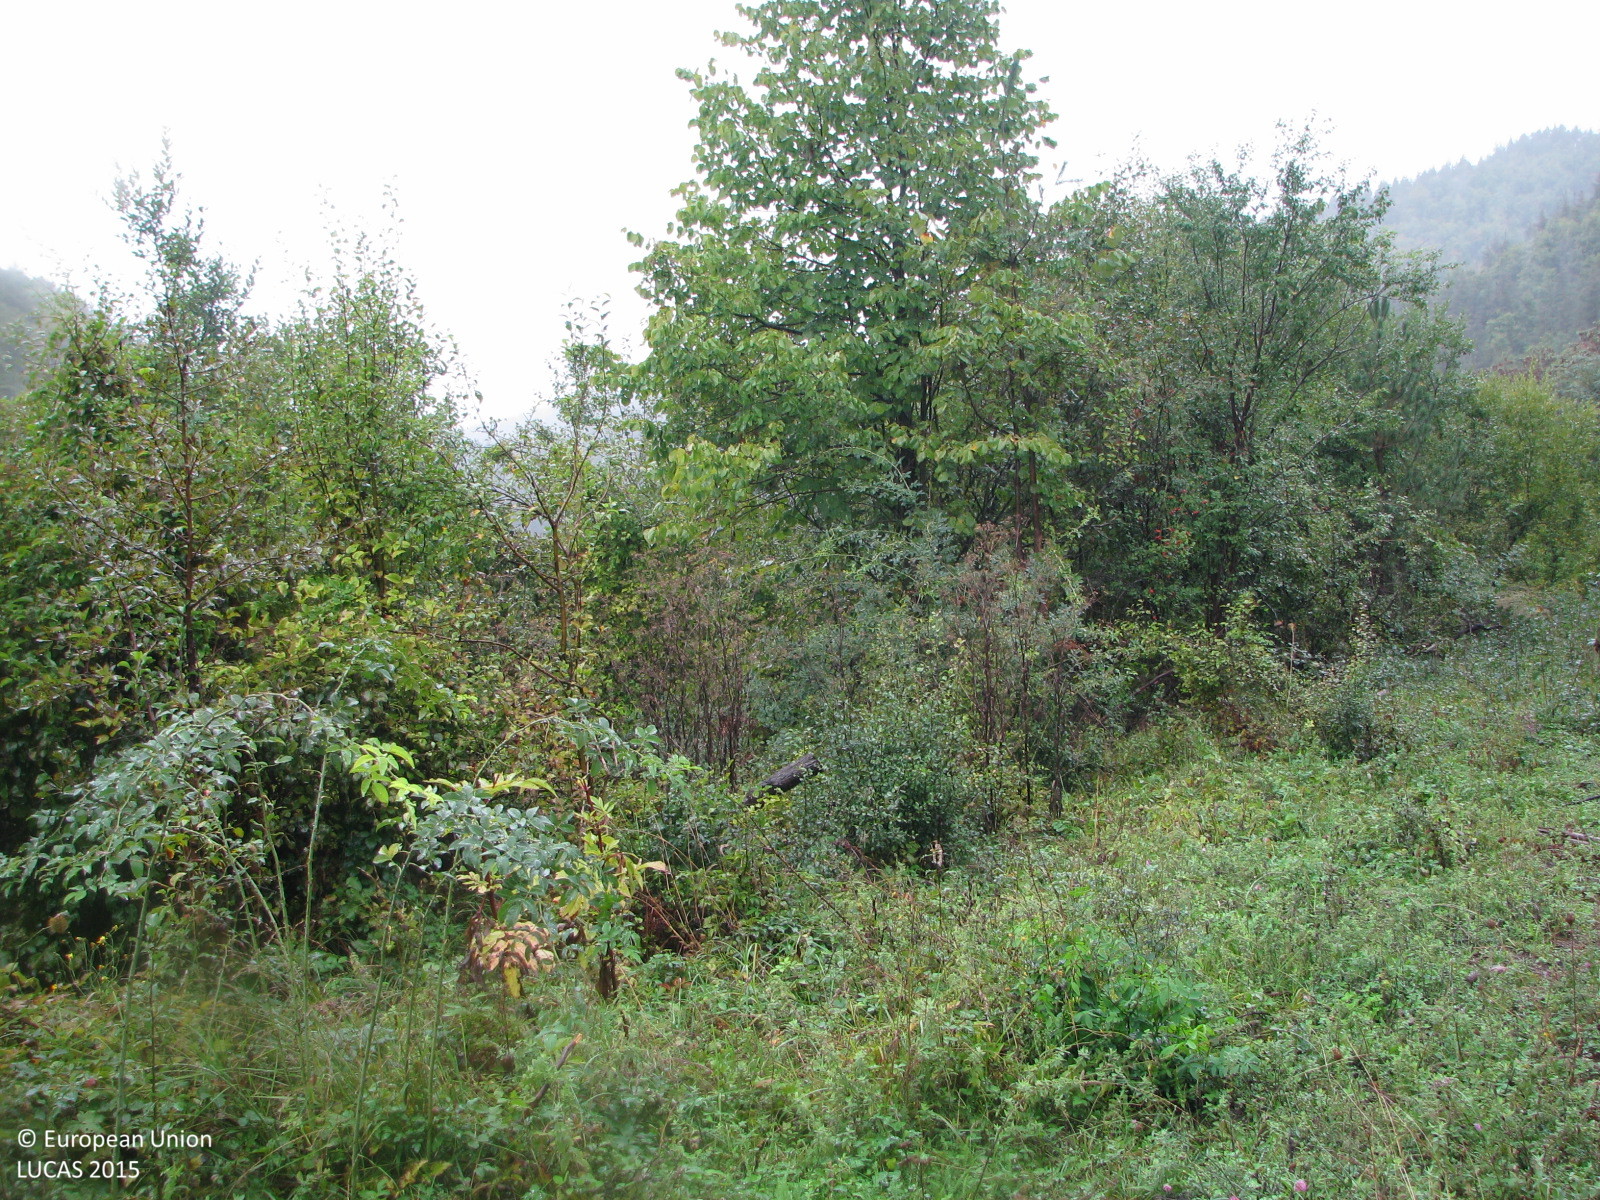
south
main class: Woodland
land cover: Broadleaved woodland
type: mesophytic deciduous forest
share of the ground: > 75 %
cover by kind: broadleaved forest trees 100 %
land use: Forestry
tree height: > 5 m
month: September
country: BG
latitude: 42.9633
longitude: 26.3883
